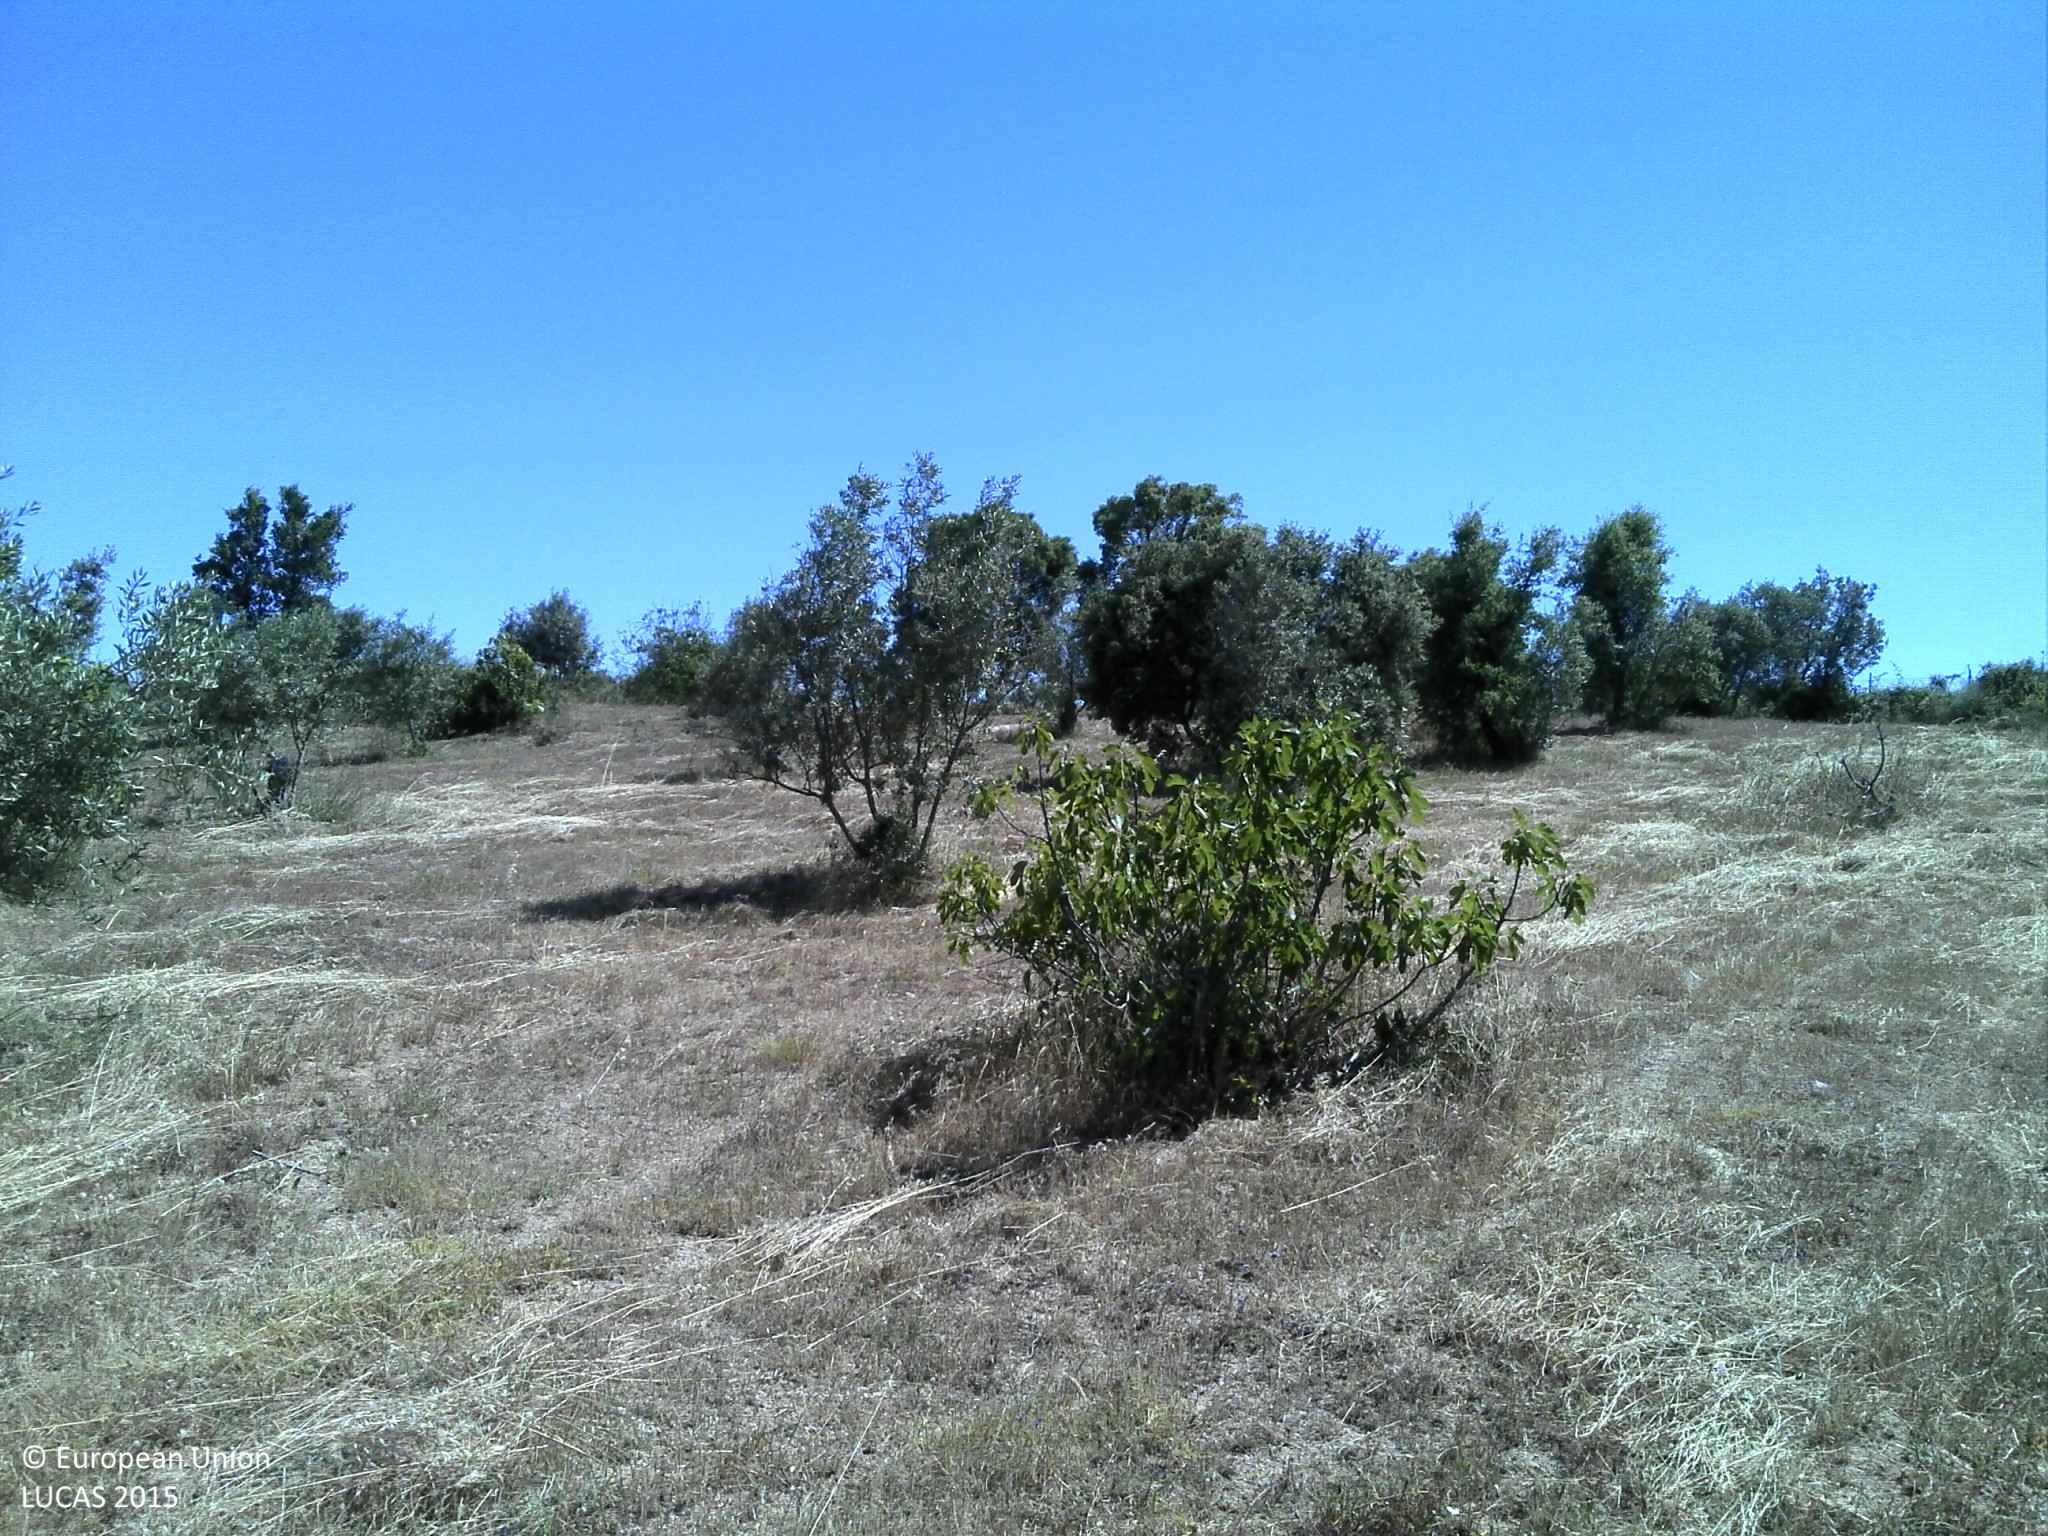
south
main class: Cropland
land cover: Olive groves
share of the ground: 25 - 50 %
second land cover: Grassland without tree/shrub cover
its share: 25 - 50 %
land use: Agriculture (excluding fallow land and kitchen gardens)
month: May
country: PT
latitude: 39.4161
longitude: -7.7170
